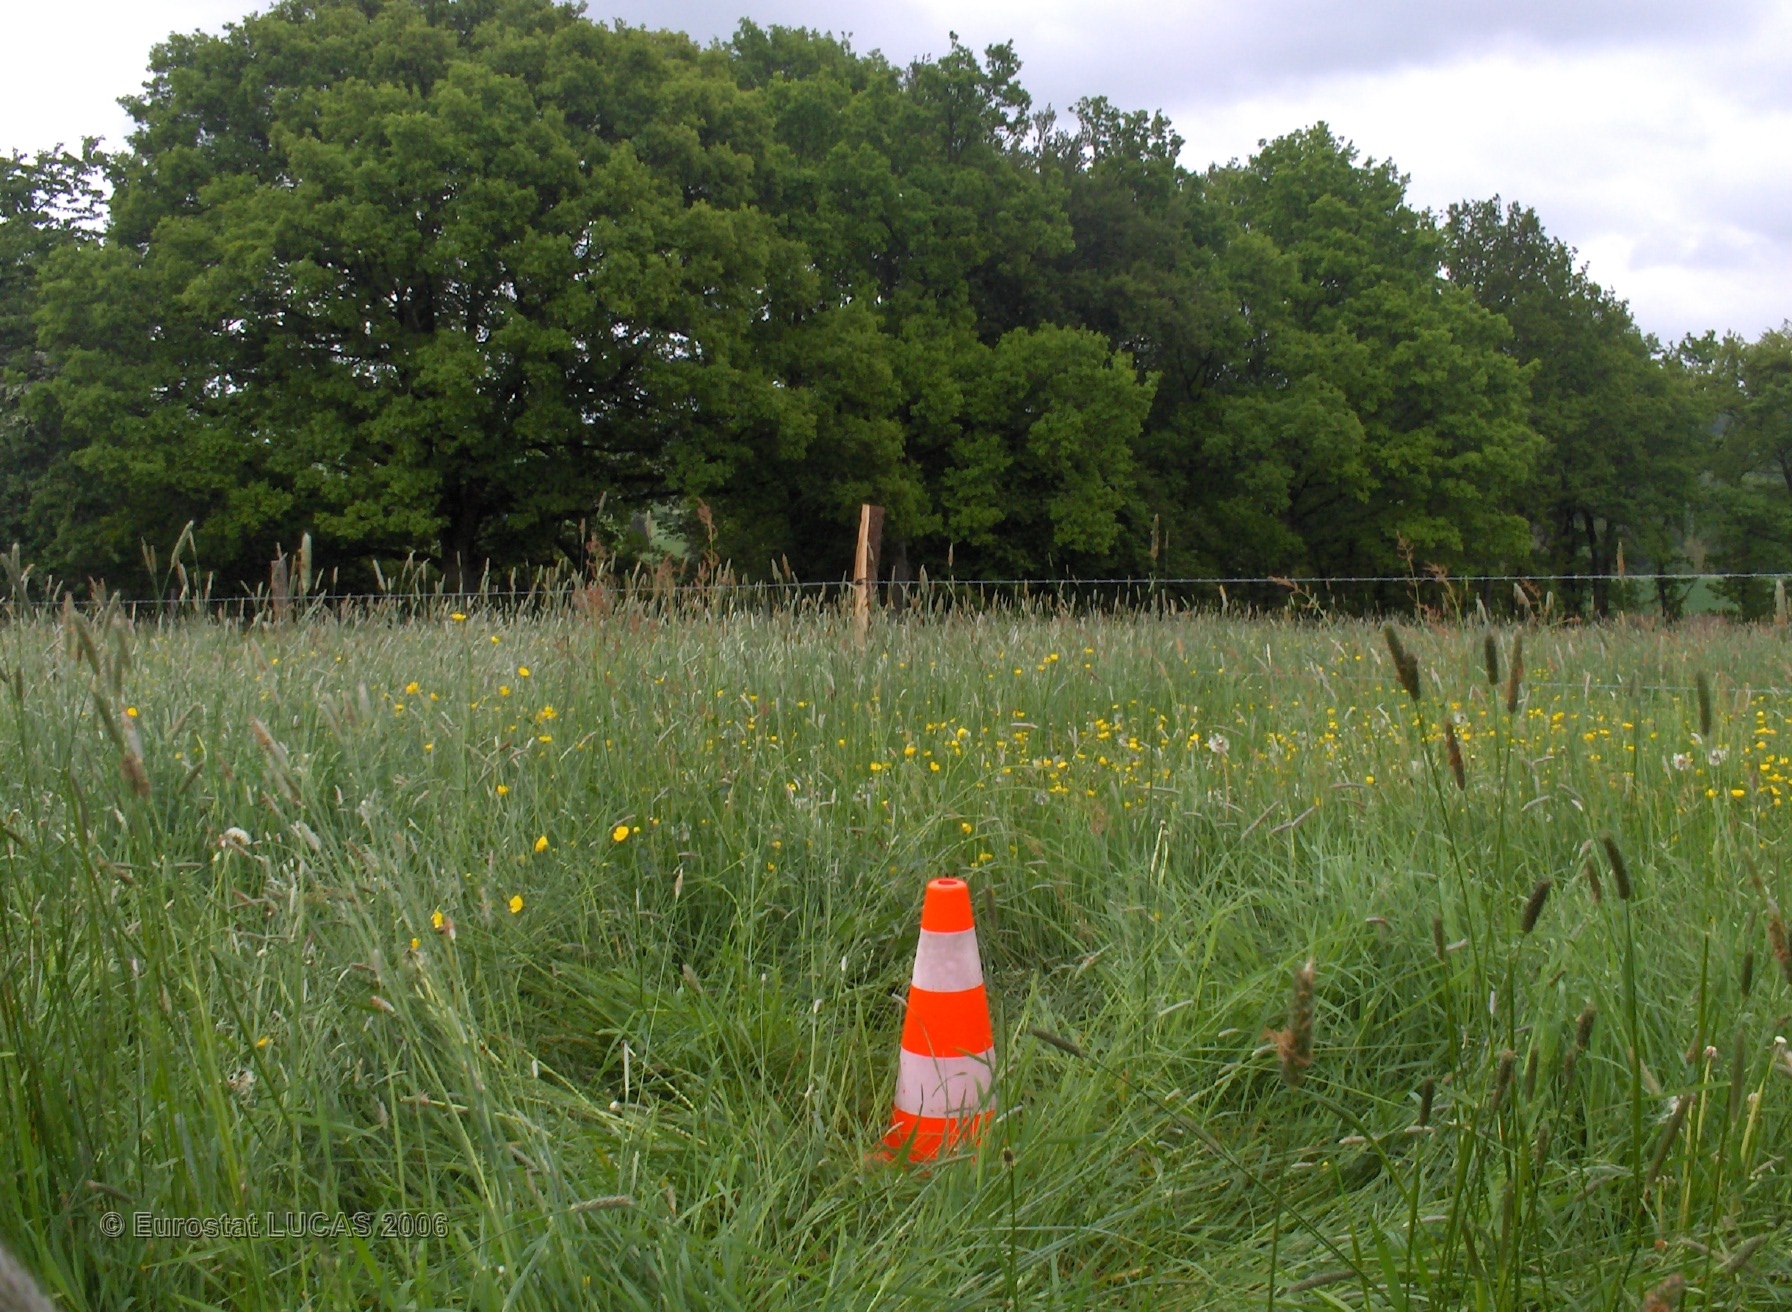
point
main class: Grassland
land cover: Grassland without tree/shrub cover
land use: Agriculture (excluding fallow land and kitchen gardens)
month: May
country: BE
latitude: 50.2651
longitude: 5.2420
